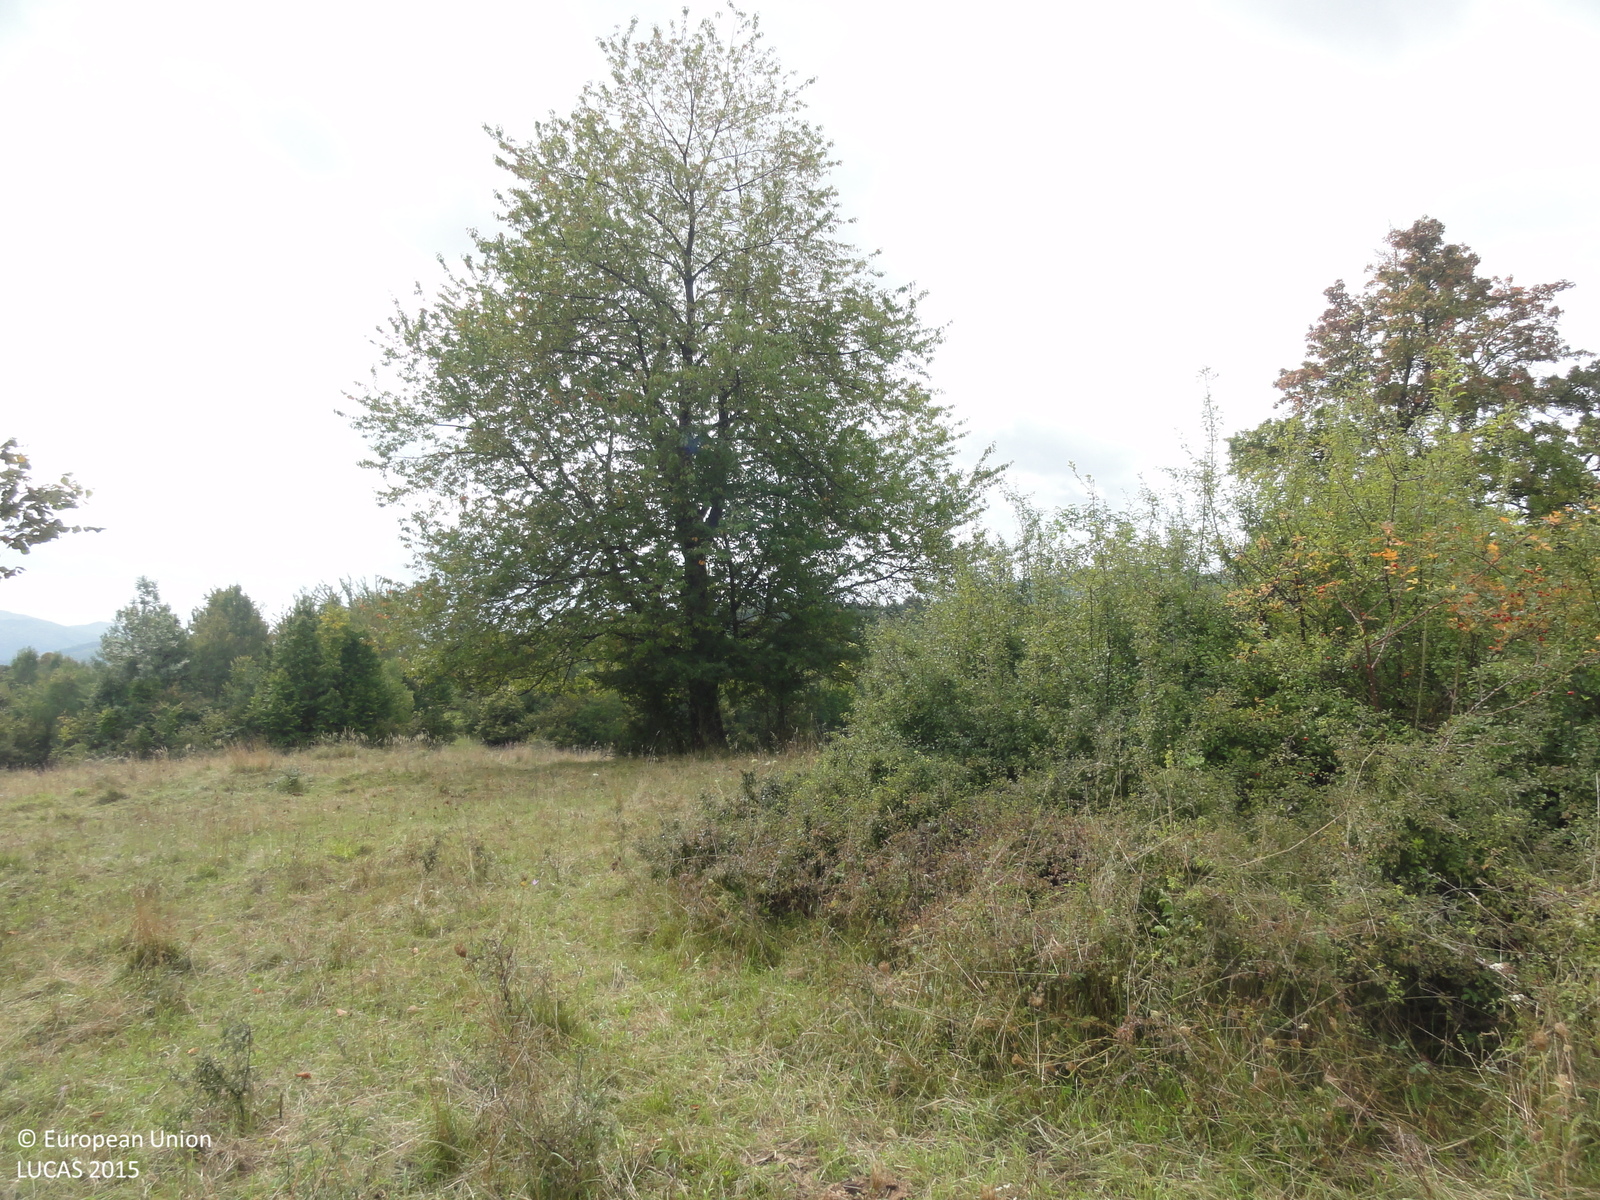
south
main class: Grassland
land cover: Grassland with sparse tree/shrub cover
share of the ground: > 75 %
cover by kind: herbaceous plants 90 %, broadleaved forest trees 5 %, shrubs 5 %
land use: Agriculture (excluding fallow land and kitchen gardens)
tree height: > 5 m
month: September
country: SI
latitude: 45.5830
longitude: 15.0328
